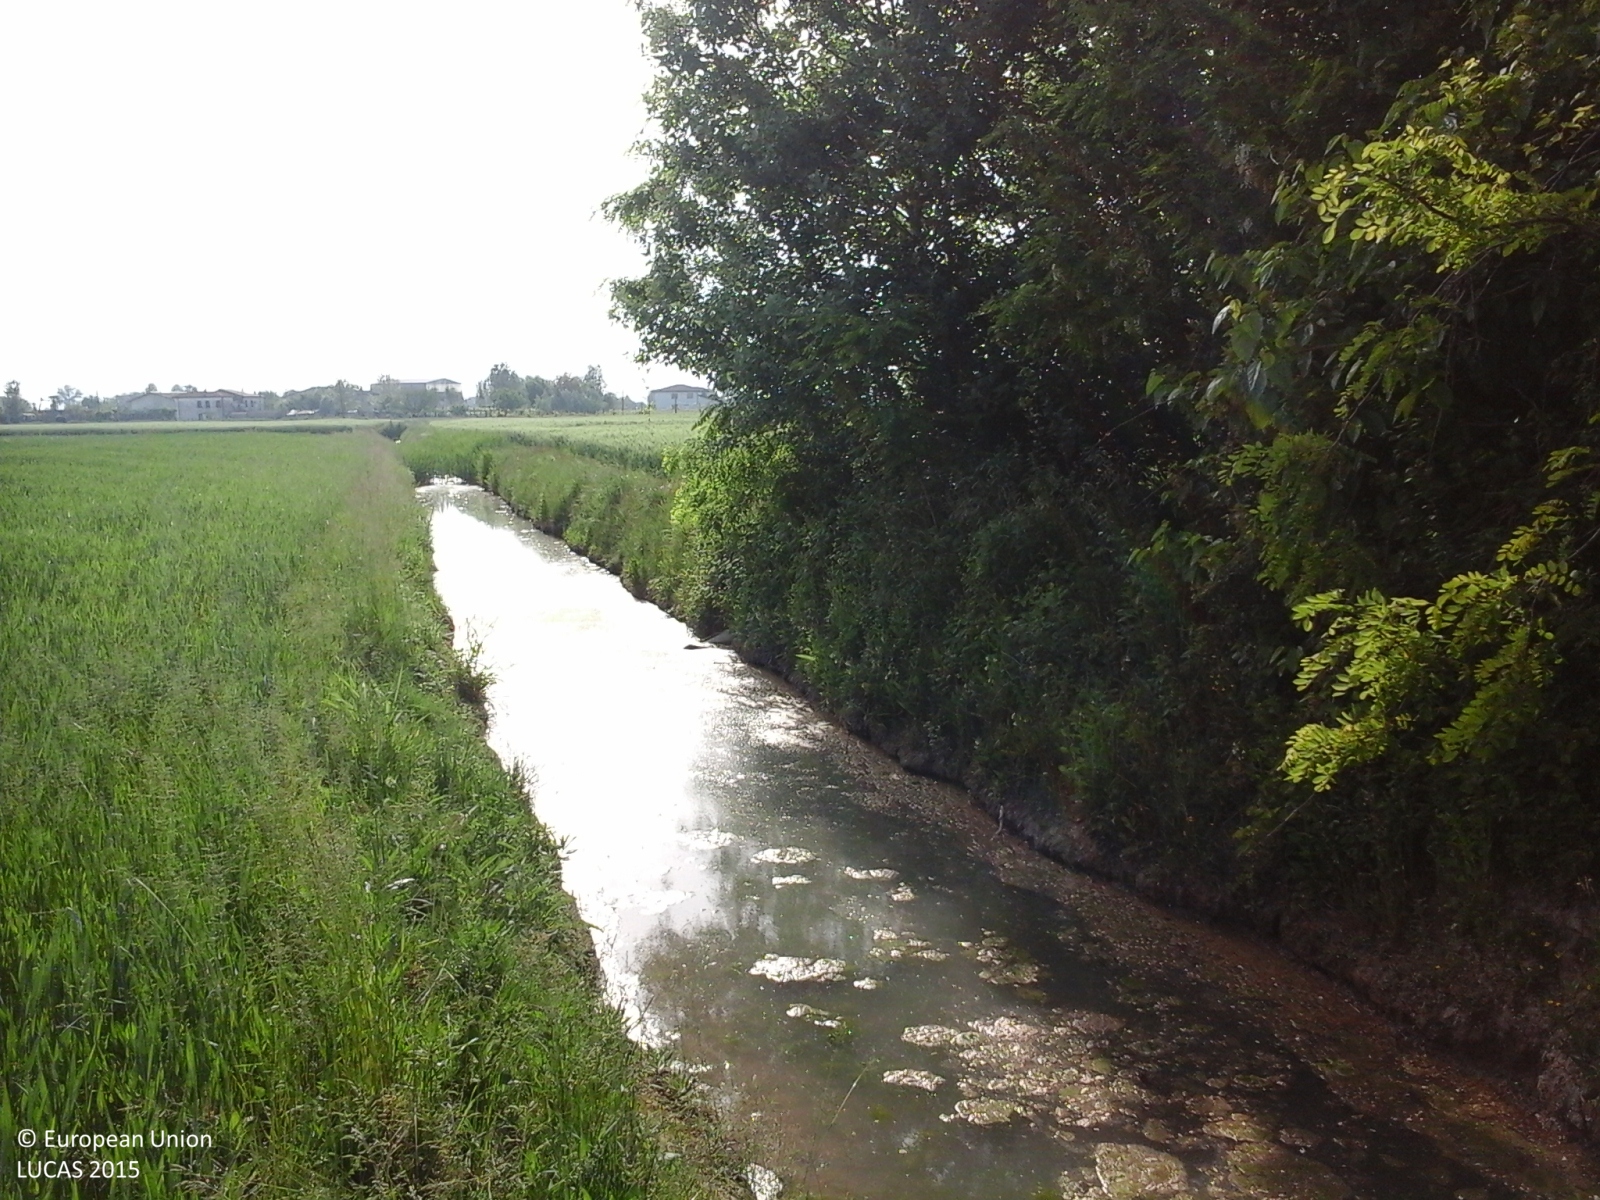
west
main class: Cropland
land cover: Common wheat
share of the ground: > 75 %
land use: Agriculture (excluding fallow land and kitchen gardens)
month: May
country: IT
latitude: 45.1664
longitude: 11.6891
